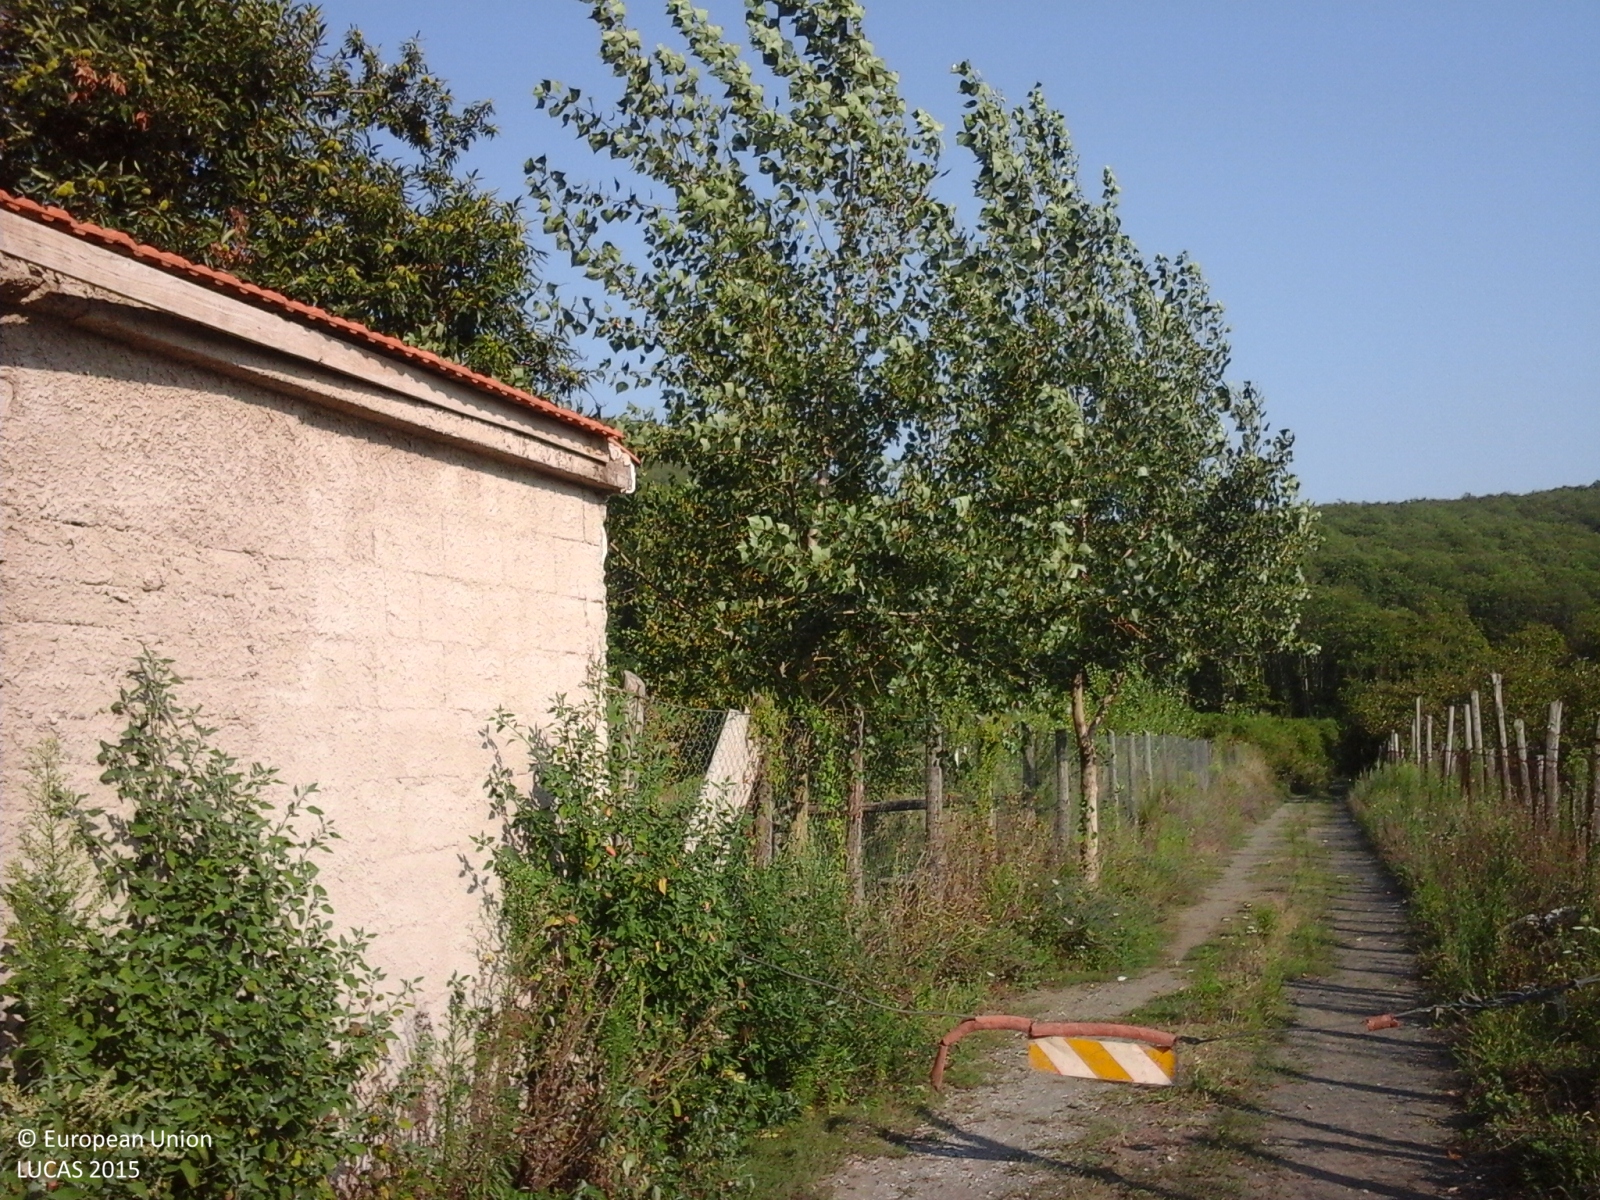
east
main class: Woodland
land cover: Broadleaved woodland
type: thermophilous deciduous forest
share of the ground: > 75 %
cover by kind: broadleaved forest trees 100 %
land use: Forestry
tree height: > 5 m
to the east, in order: Broadleaved woodland; Tracks; Broadleaved woodland
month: August
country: IT
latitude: 40.8483
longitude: 14.5953
